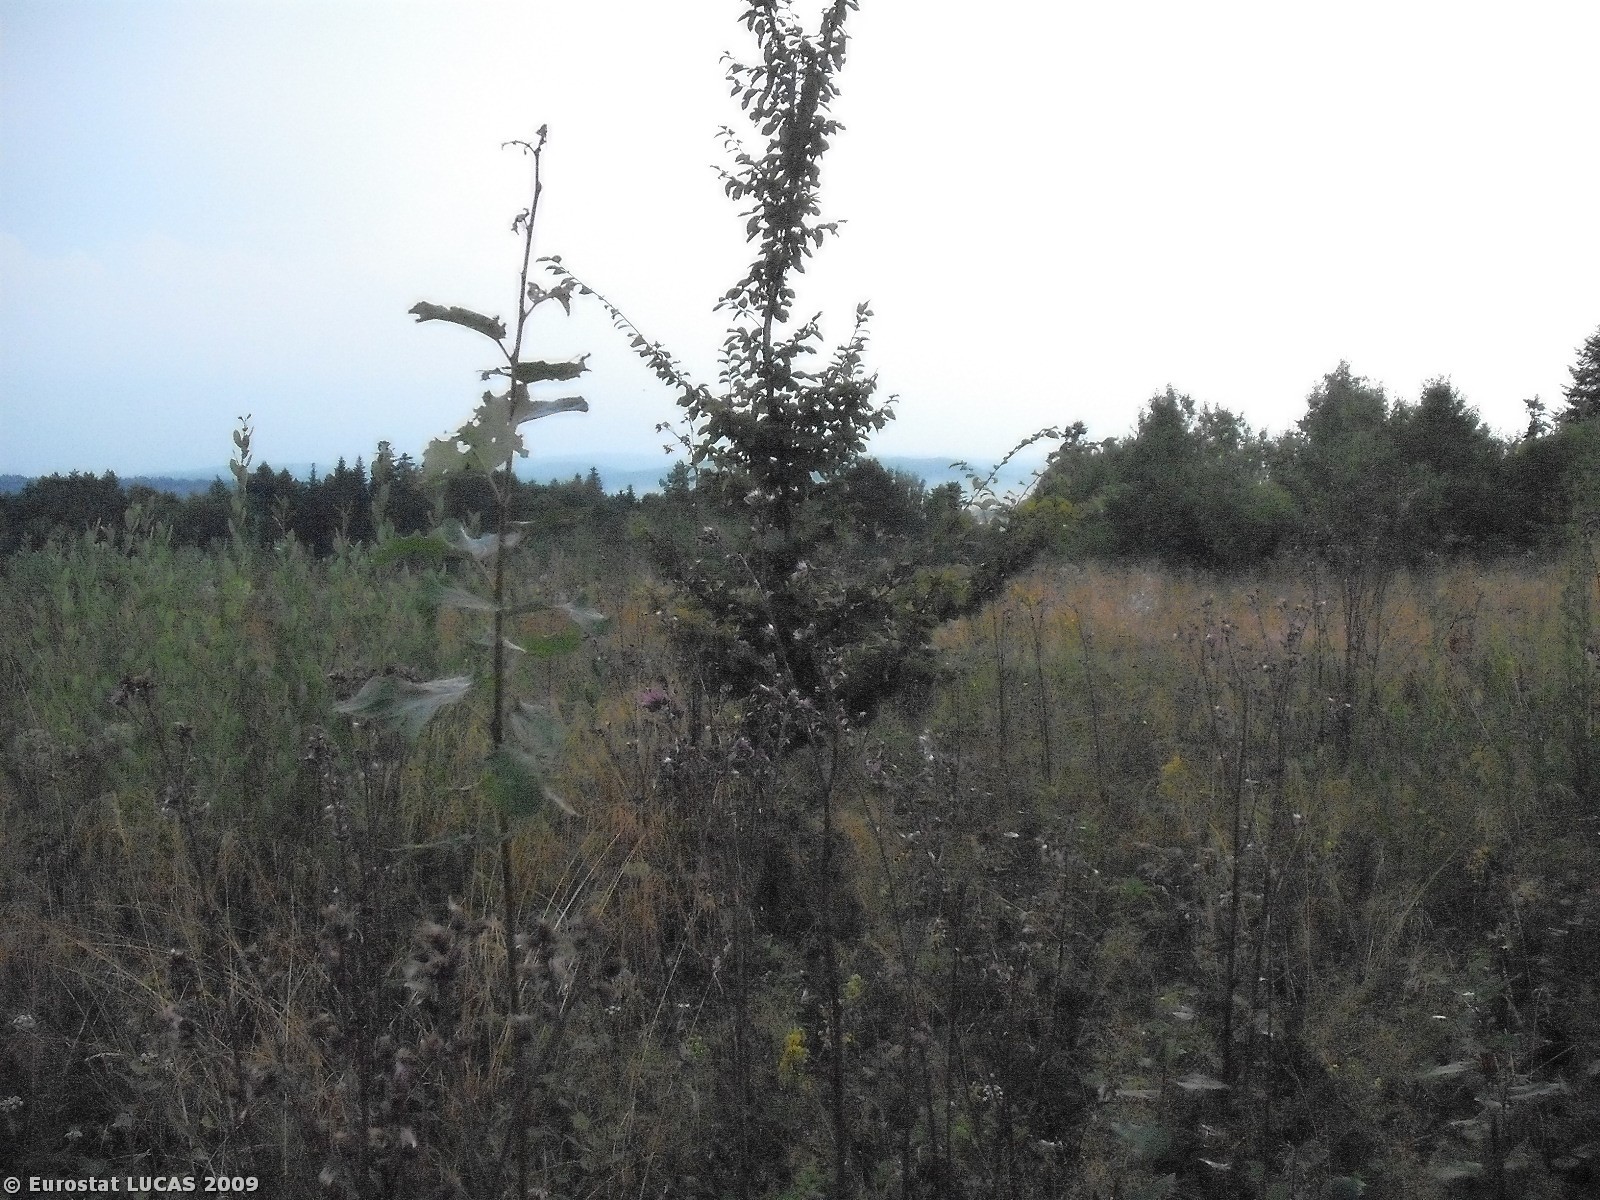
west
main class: Woodland
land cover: Broadleaved woodland
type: mesophytic deciduous forest
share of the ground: 25 - 50 %
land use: Unused
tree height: > 5 m
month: August
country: PL
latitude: 49.8002
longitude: 22.0196
